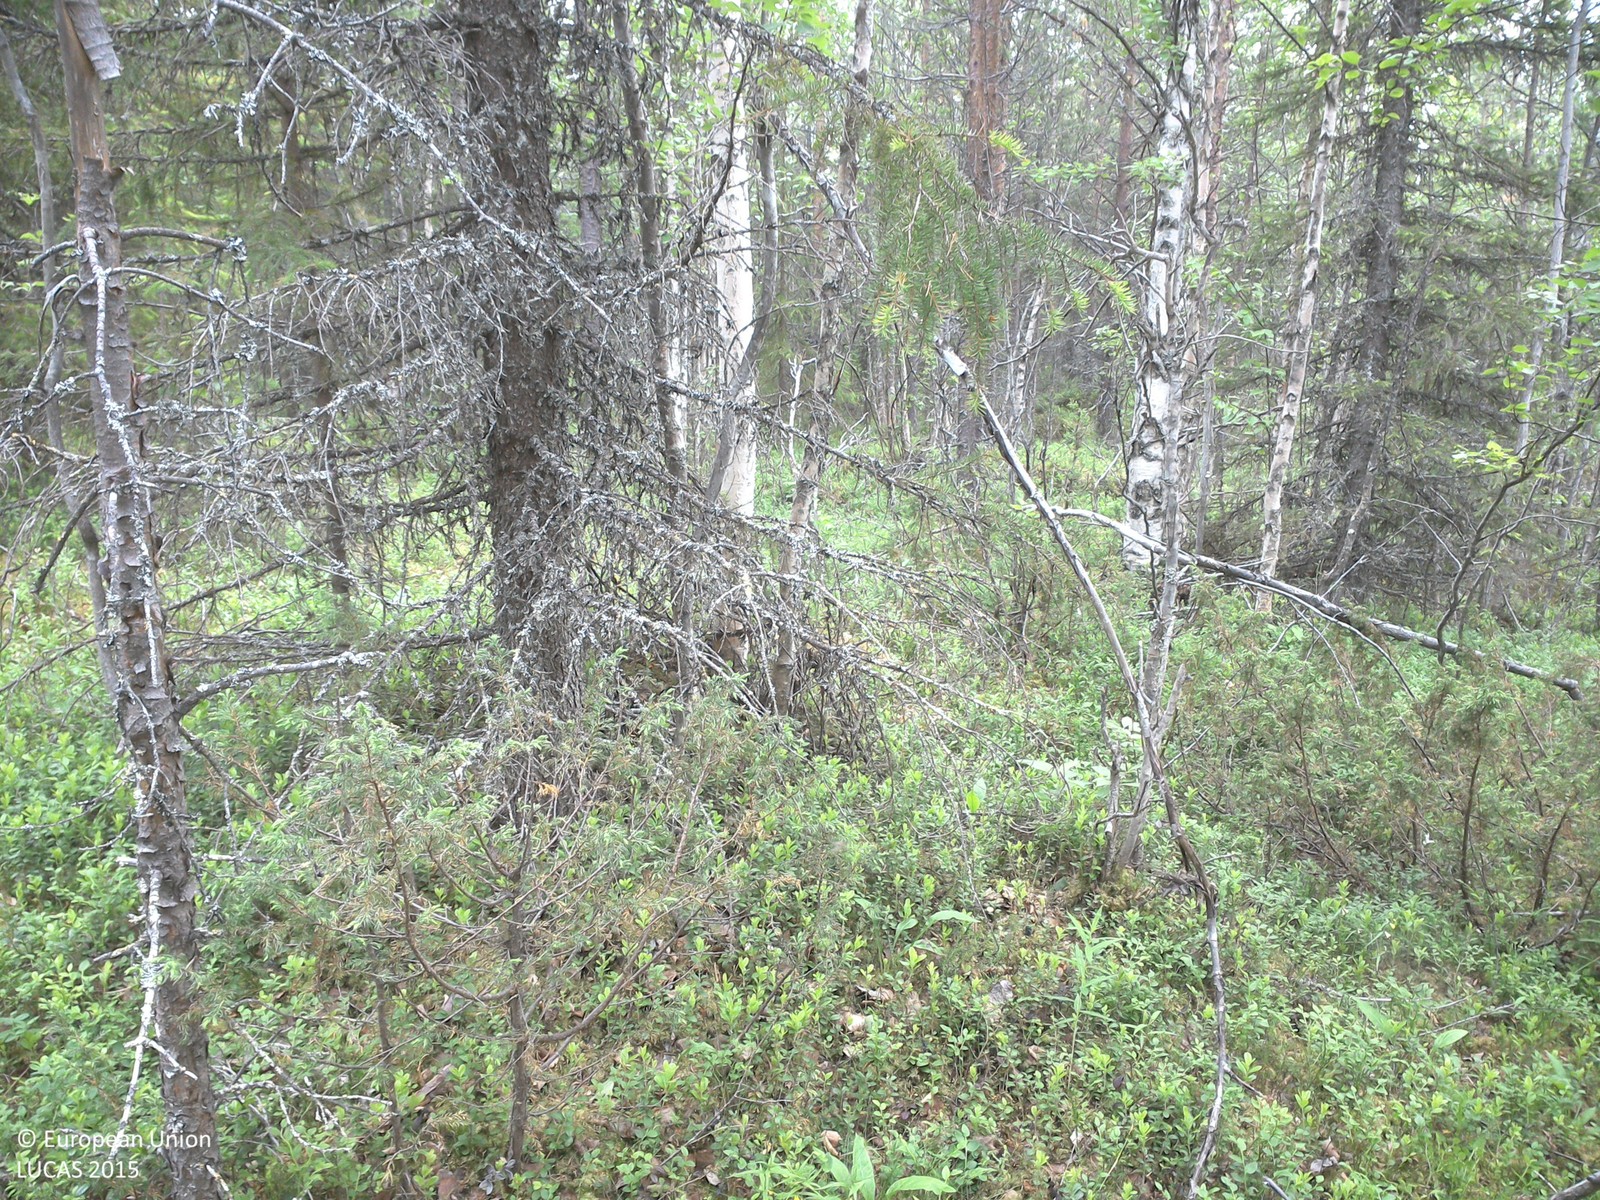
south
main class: Woodland
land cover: Pine dominated mixed woodland
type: boreal forest
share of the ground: 25 - 50 %
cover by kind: shrubs 55 %, coniferous forest trees 20 %, broadleaved forest trees 15 %, lichens and mosses 10 %
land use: Forestry
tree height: > 5 m
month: July
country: SE
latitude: 66.8476
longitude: 23.1251
